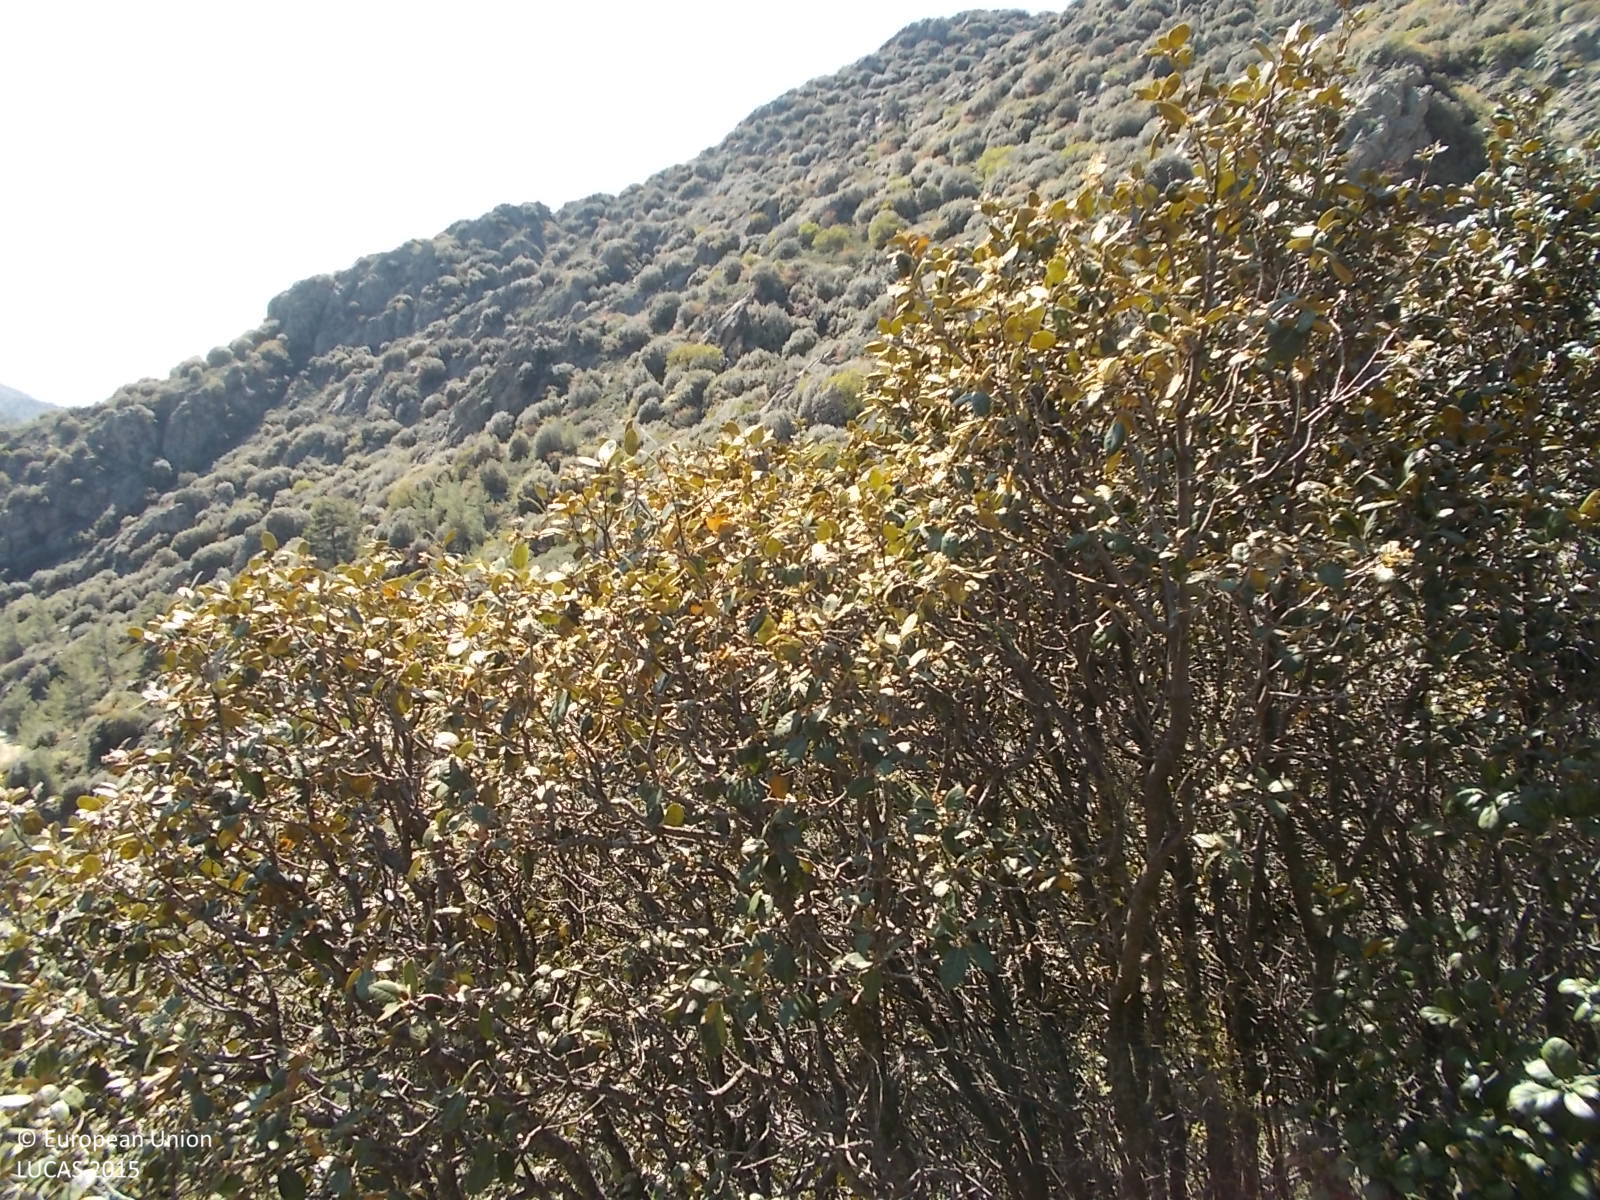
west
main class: Shrubland
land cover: Shrubland with sparse tree cover
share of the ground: > 75 %
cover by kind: shrubs 95 %, broadleaved forest trees 5 %
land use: Semi-natural and natural areas not in use
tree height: > 5 m
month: May
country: CY
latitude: 34.8929
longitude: 33.0532
